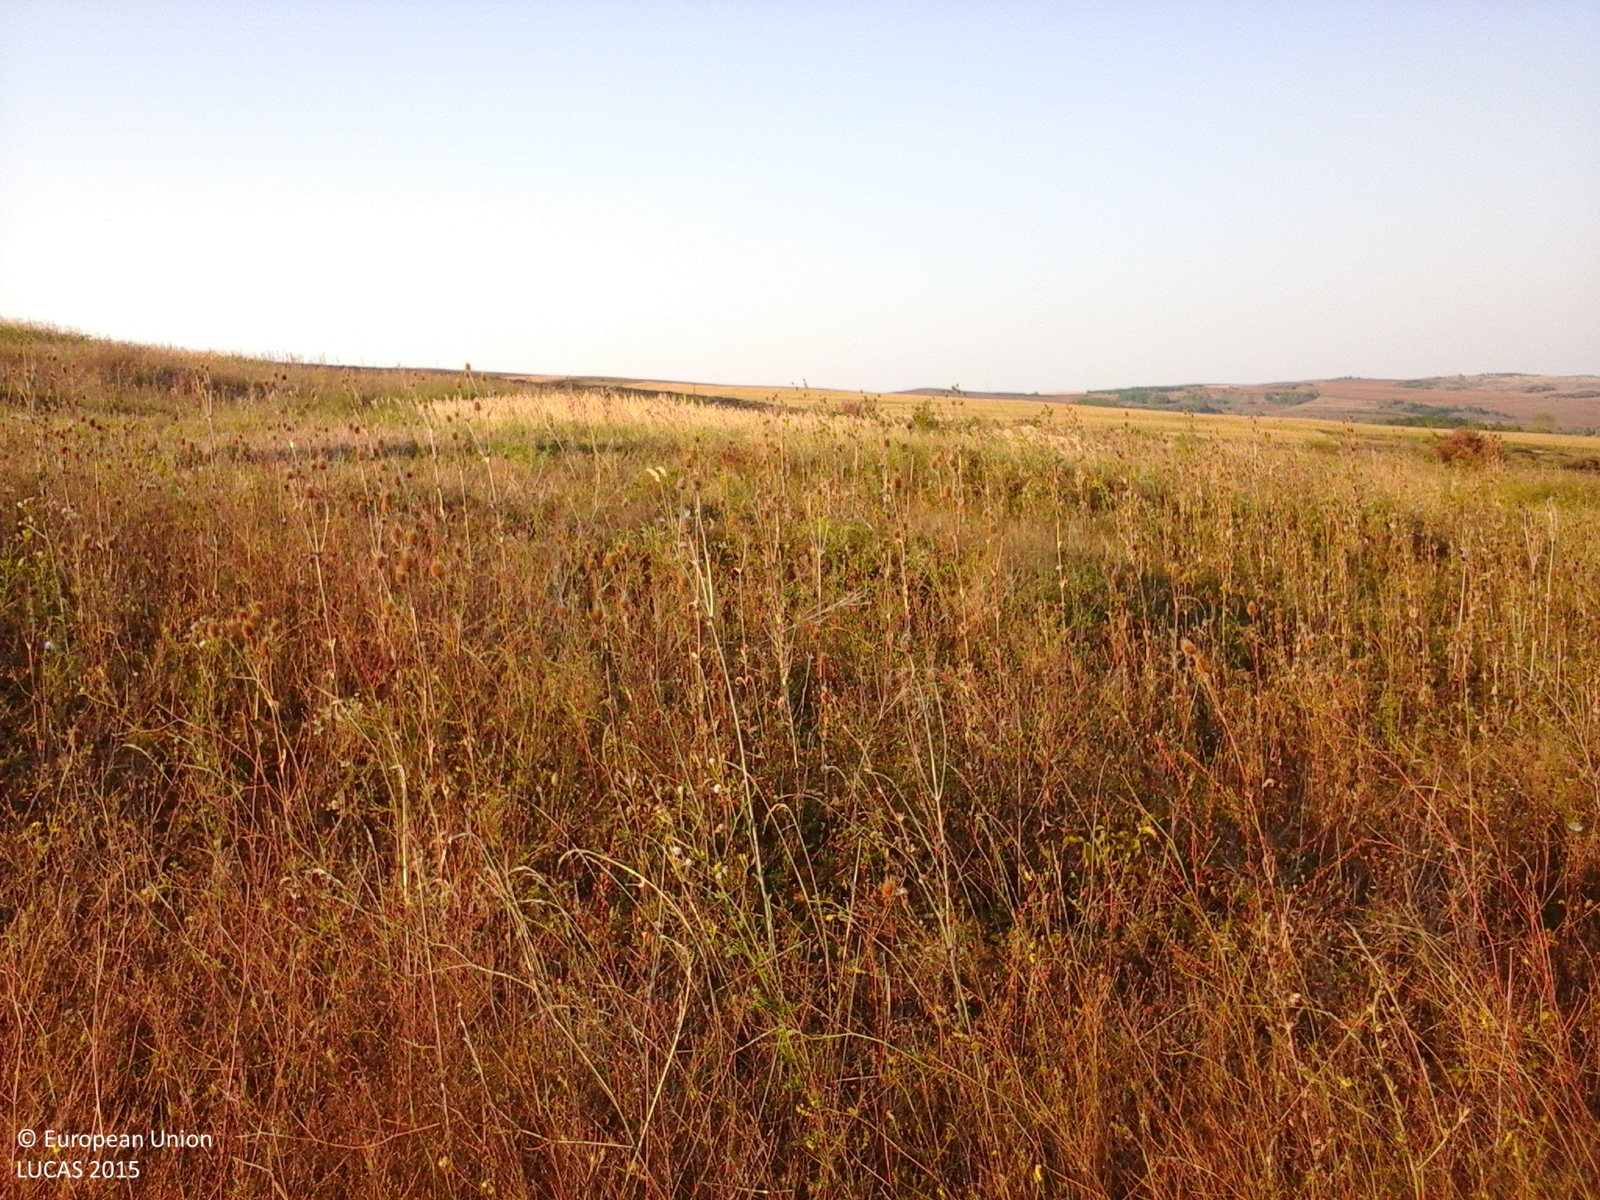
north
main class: Cropland
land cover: Oats
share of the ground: < 10 %
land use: Agriculture (excluding fallow land and kitchen gardens)
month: September
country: RO
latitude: 47.2994
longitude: 23.0383
